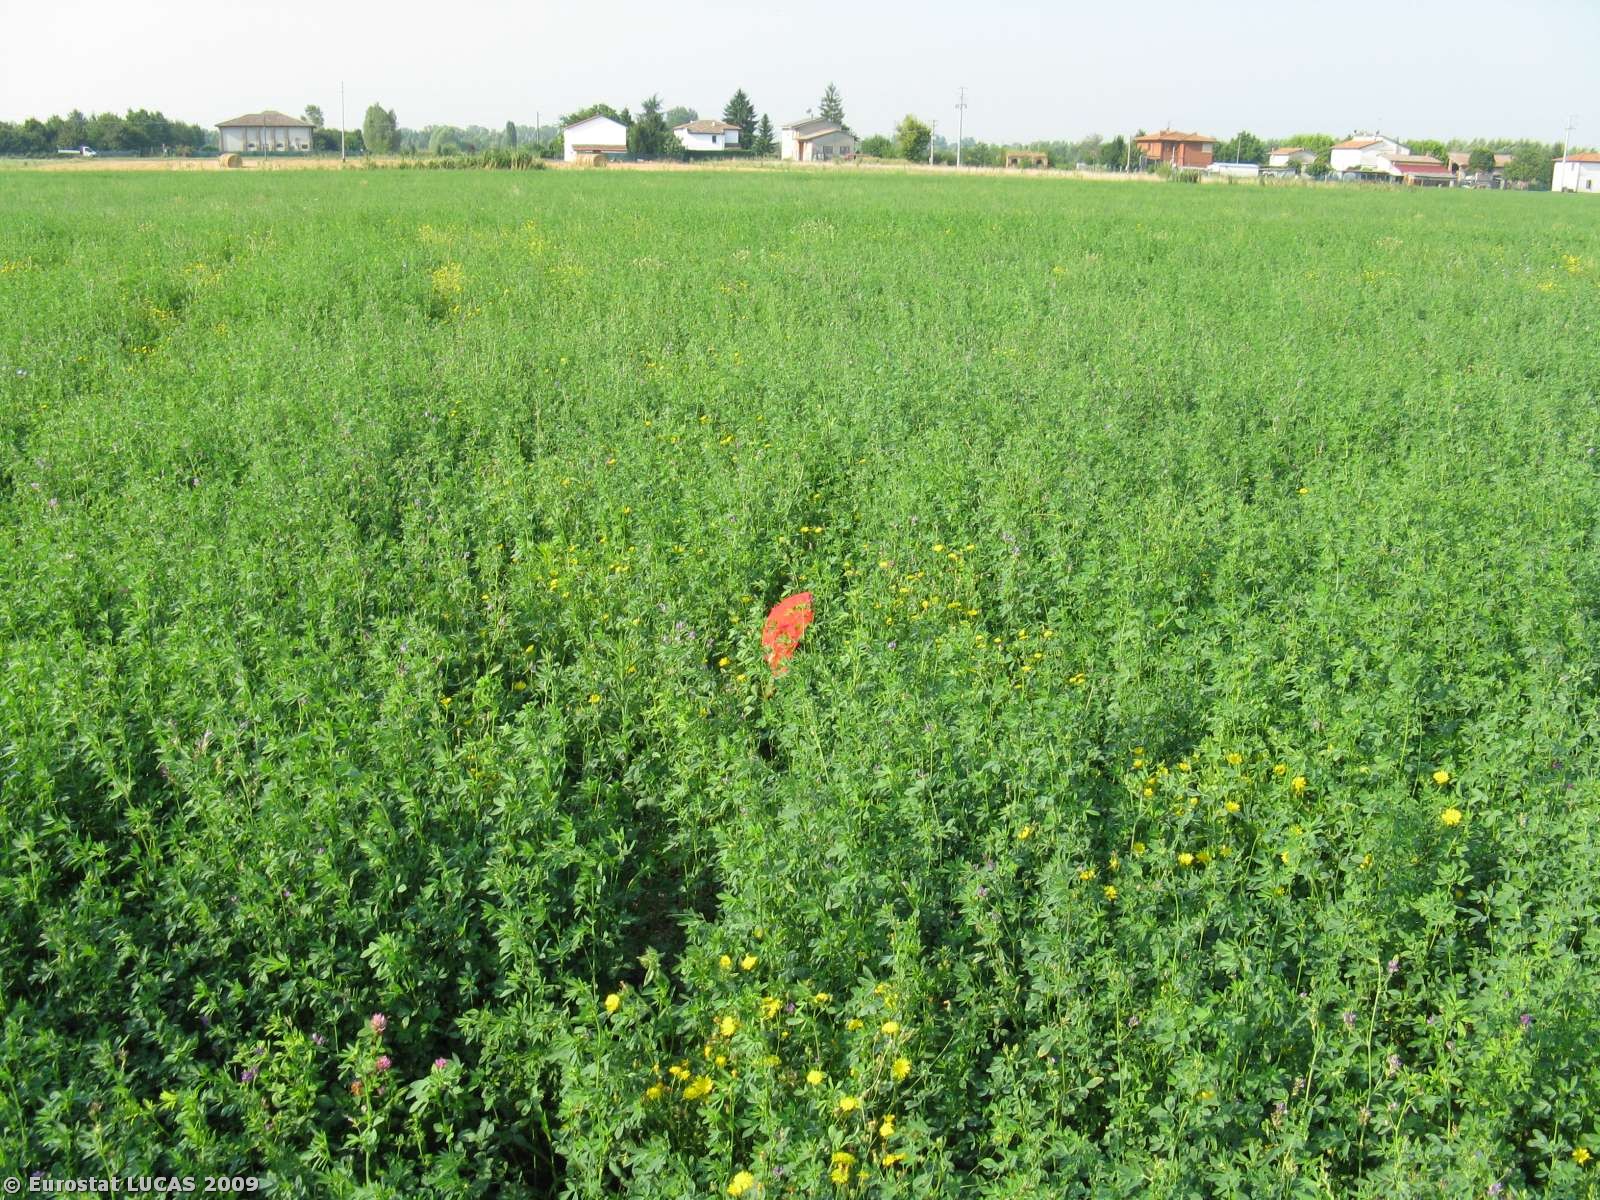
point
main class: Cropland
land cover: Lucerne
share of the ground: > 75 %
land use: Agriculture (excluding fallow land and kitchen gardens)
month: July
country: IT
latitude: 44.5900
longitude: 11.6467
